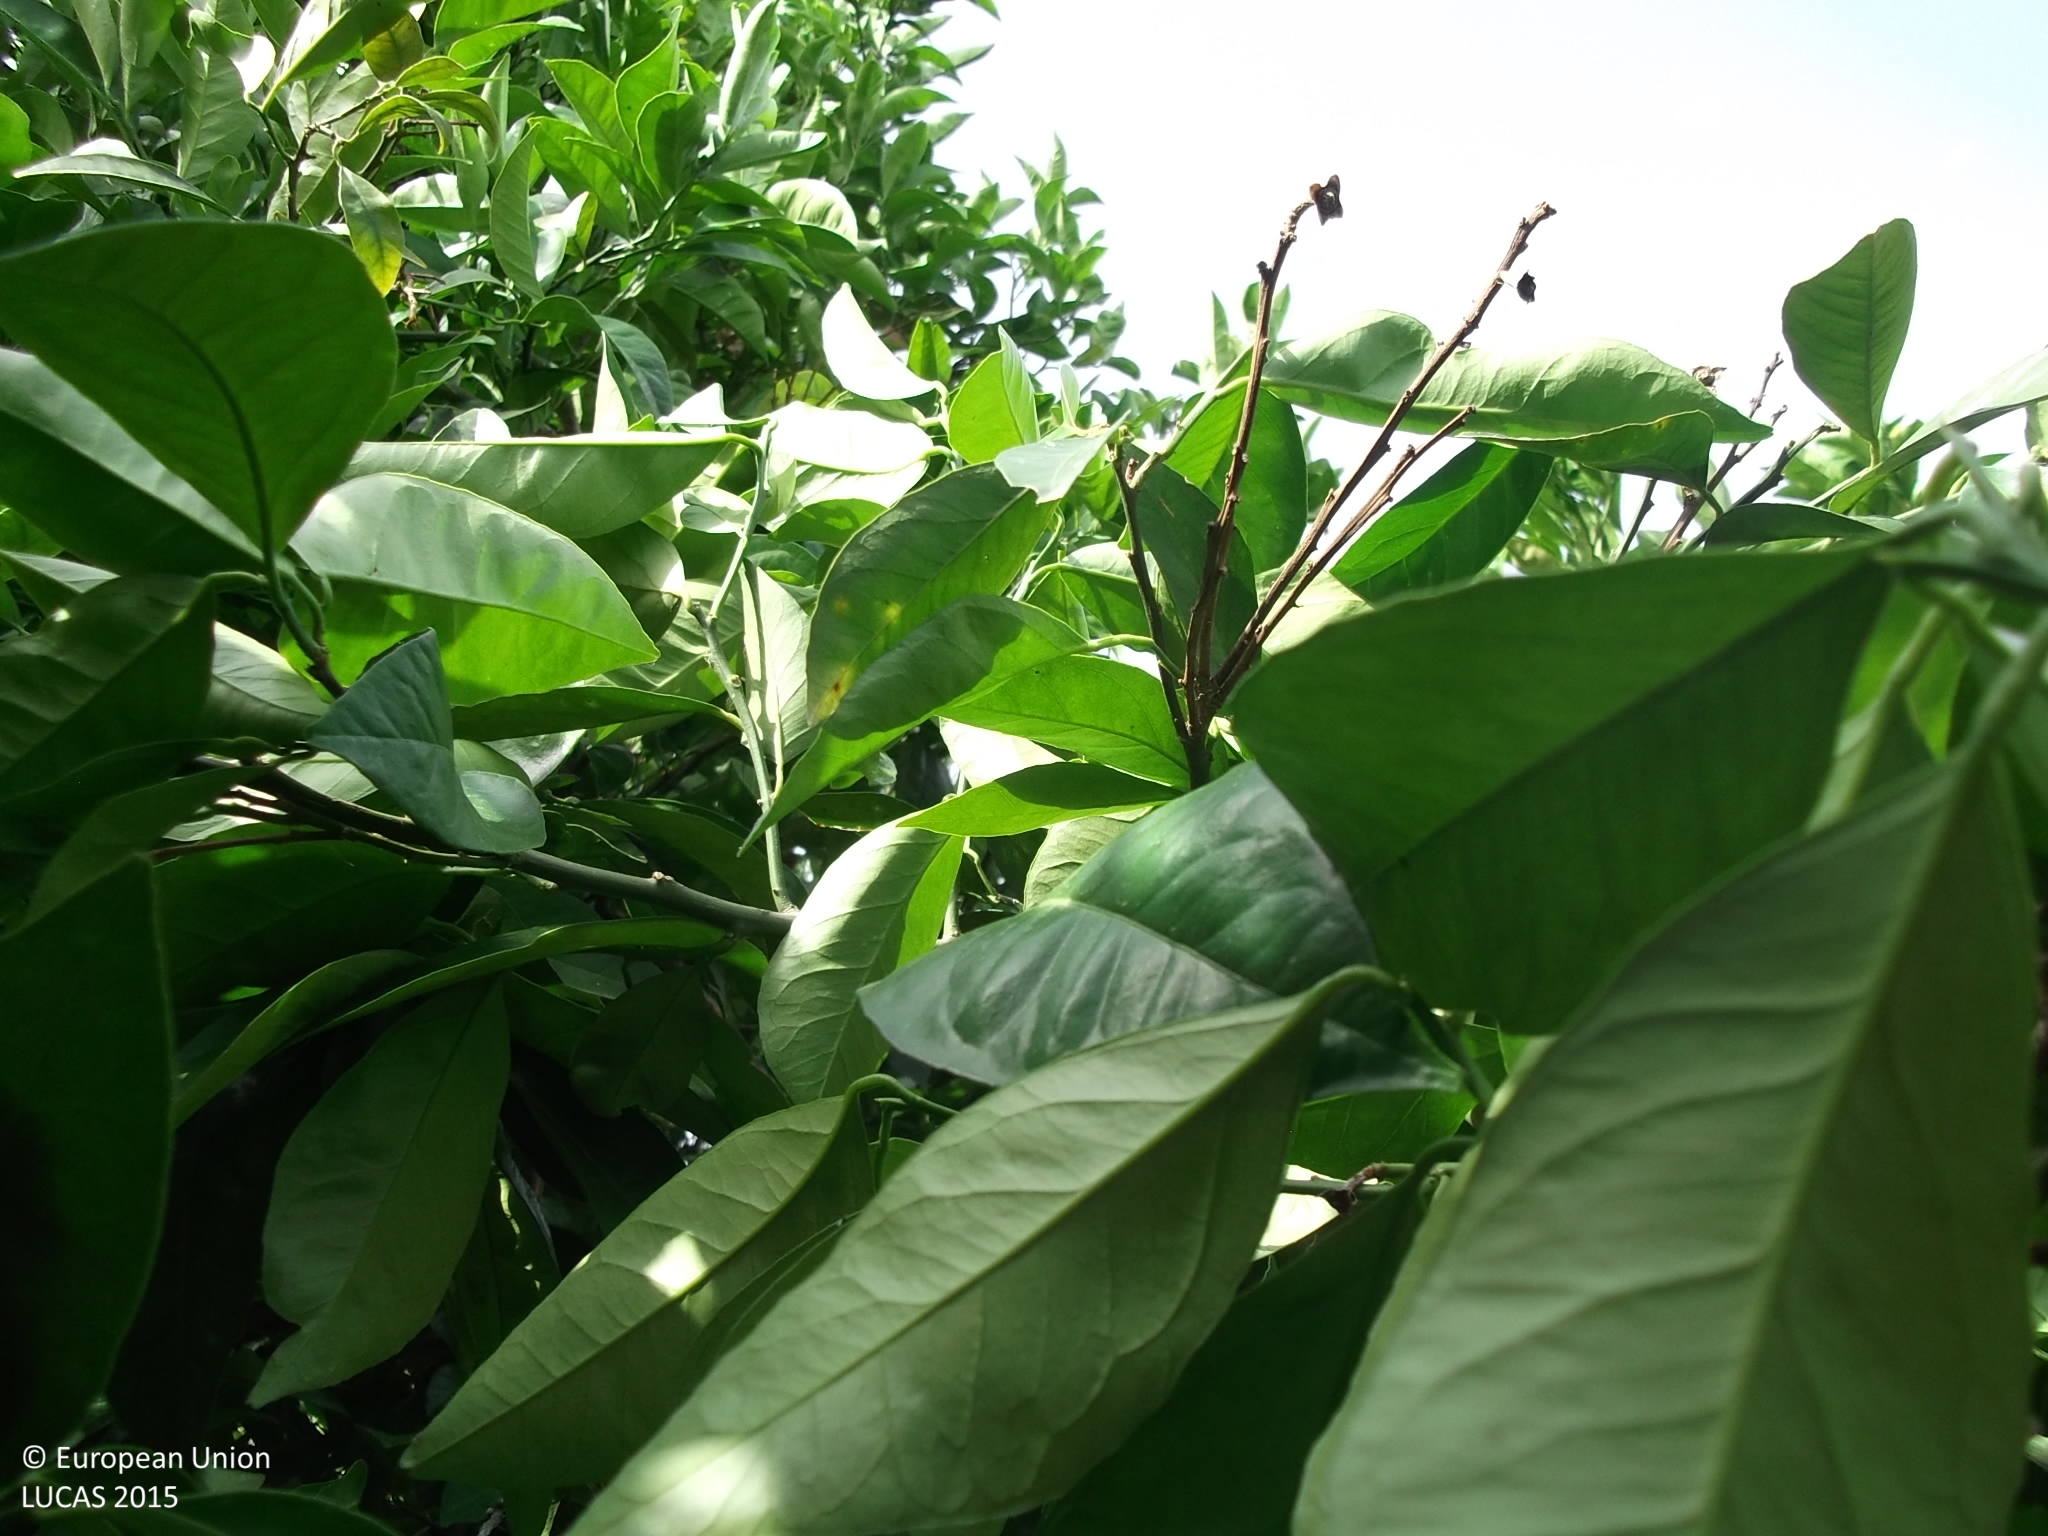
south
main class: Cropland
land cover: Oranges
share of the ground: > 75 %
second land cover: Other bare soil
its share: > 75 %
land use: Agriculture (excluding fallow land and kitchen gardens)
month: May
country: CY
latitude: 34.9898
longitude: 32.4468
